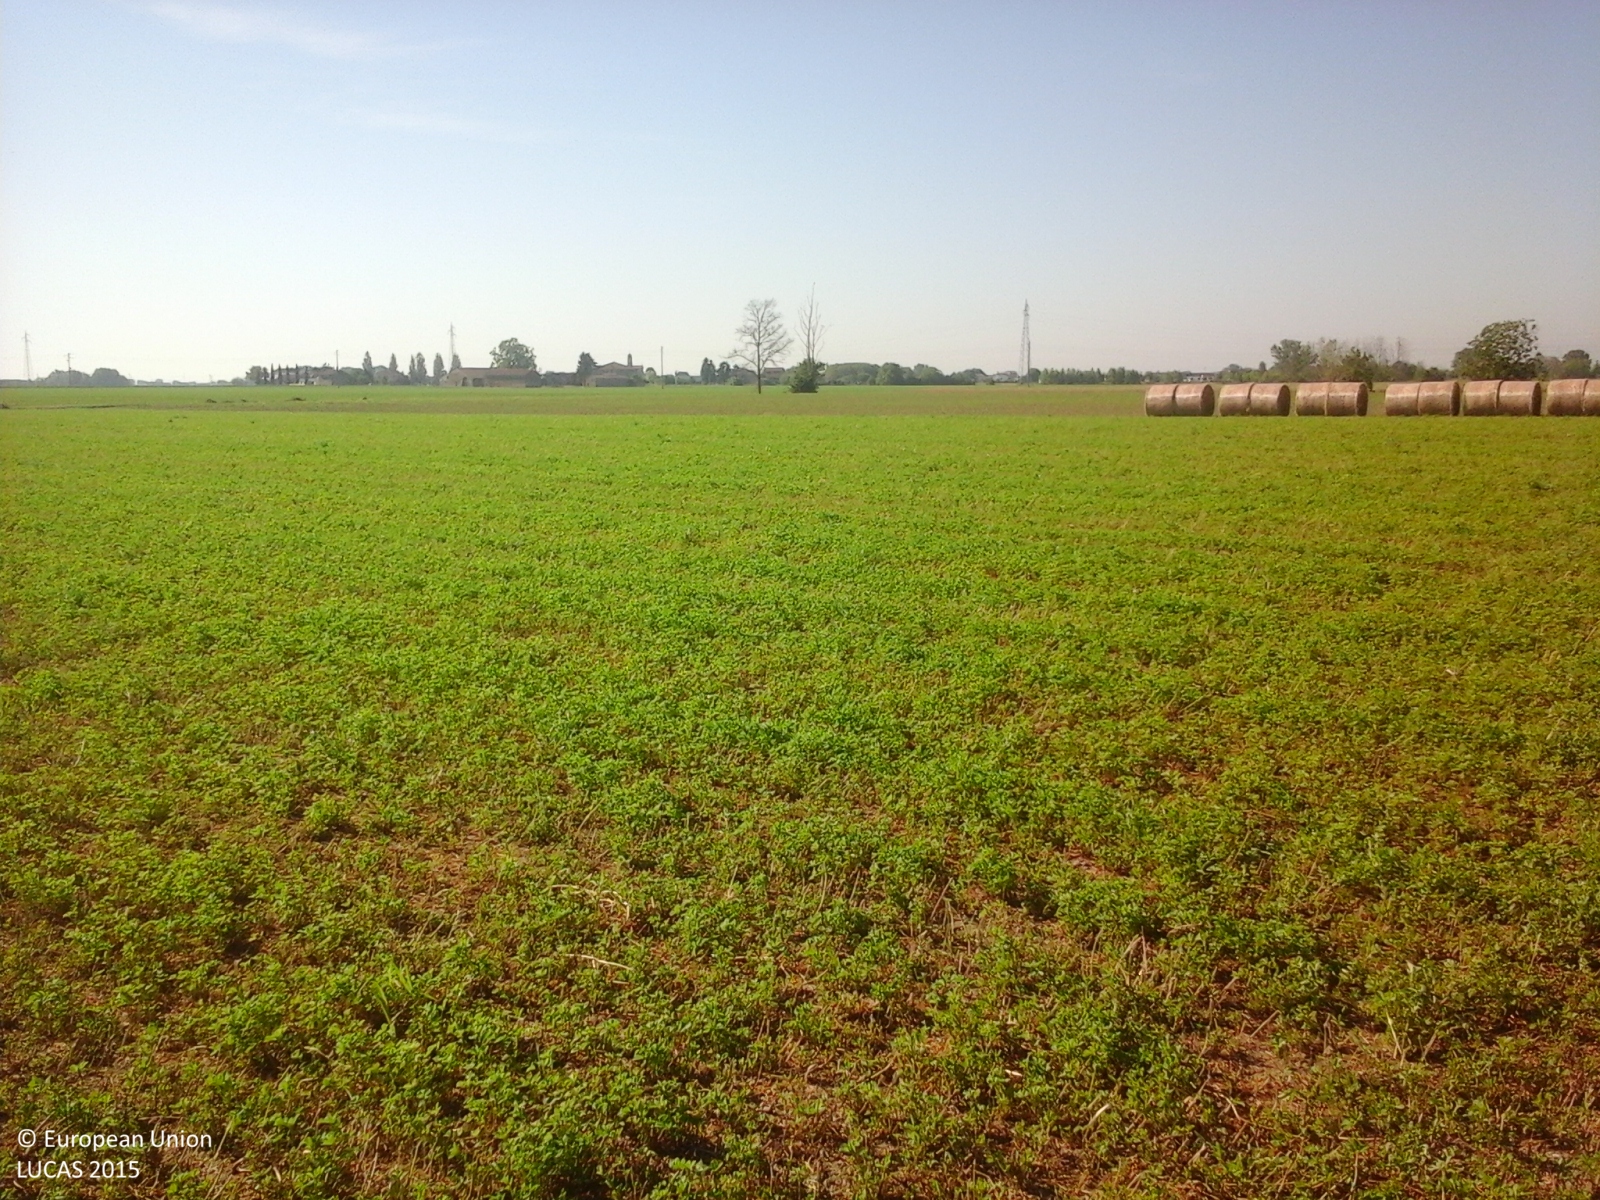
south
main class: Cropland
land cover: Lucerne
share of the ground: > 75 %
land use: Agriculture (excluding fallow land and kitchen gardens)
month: May
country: IT
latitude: 44.9967
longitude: 10.7976
